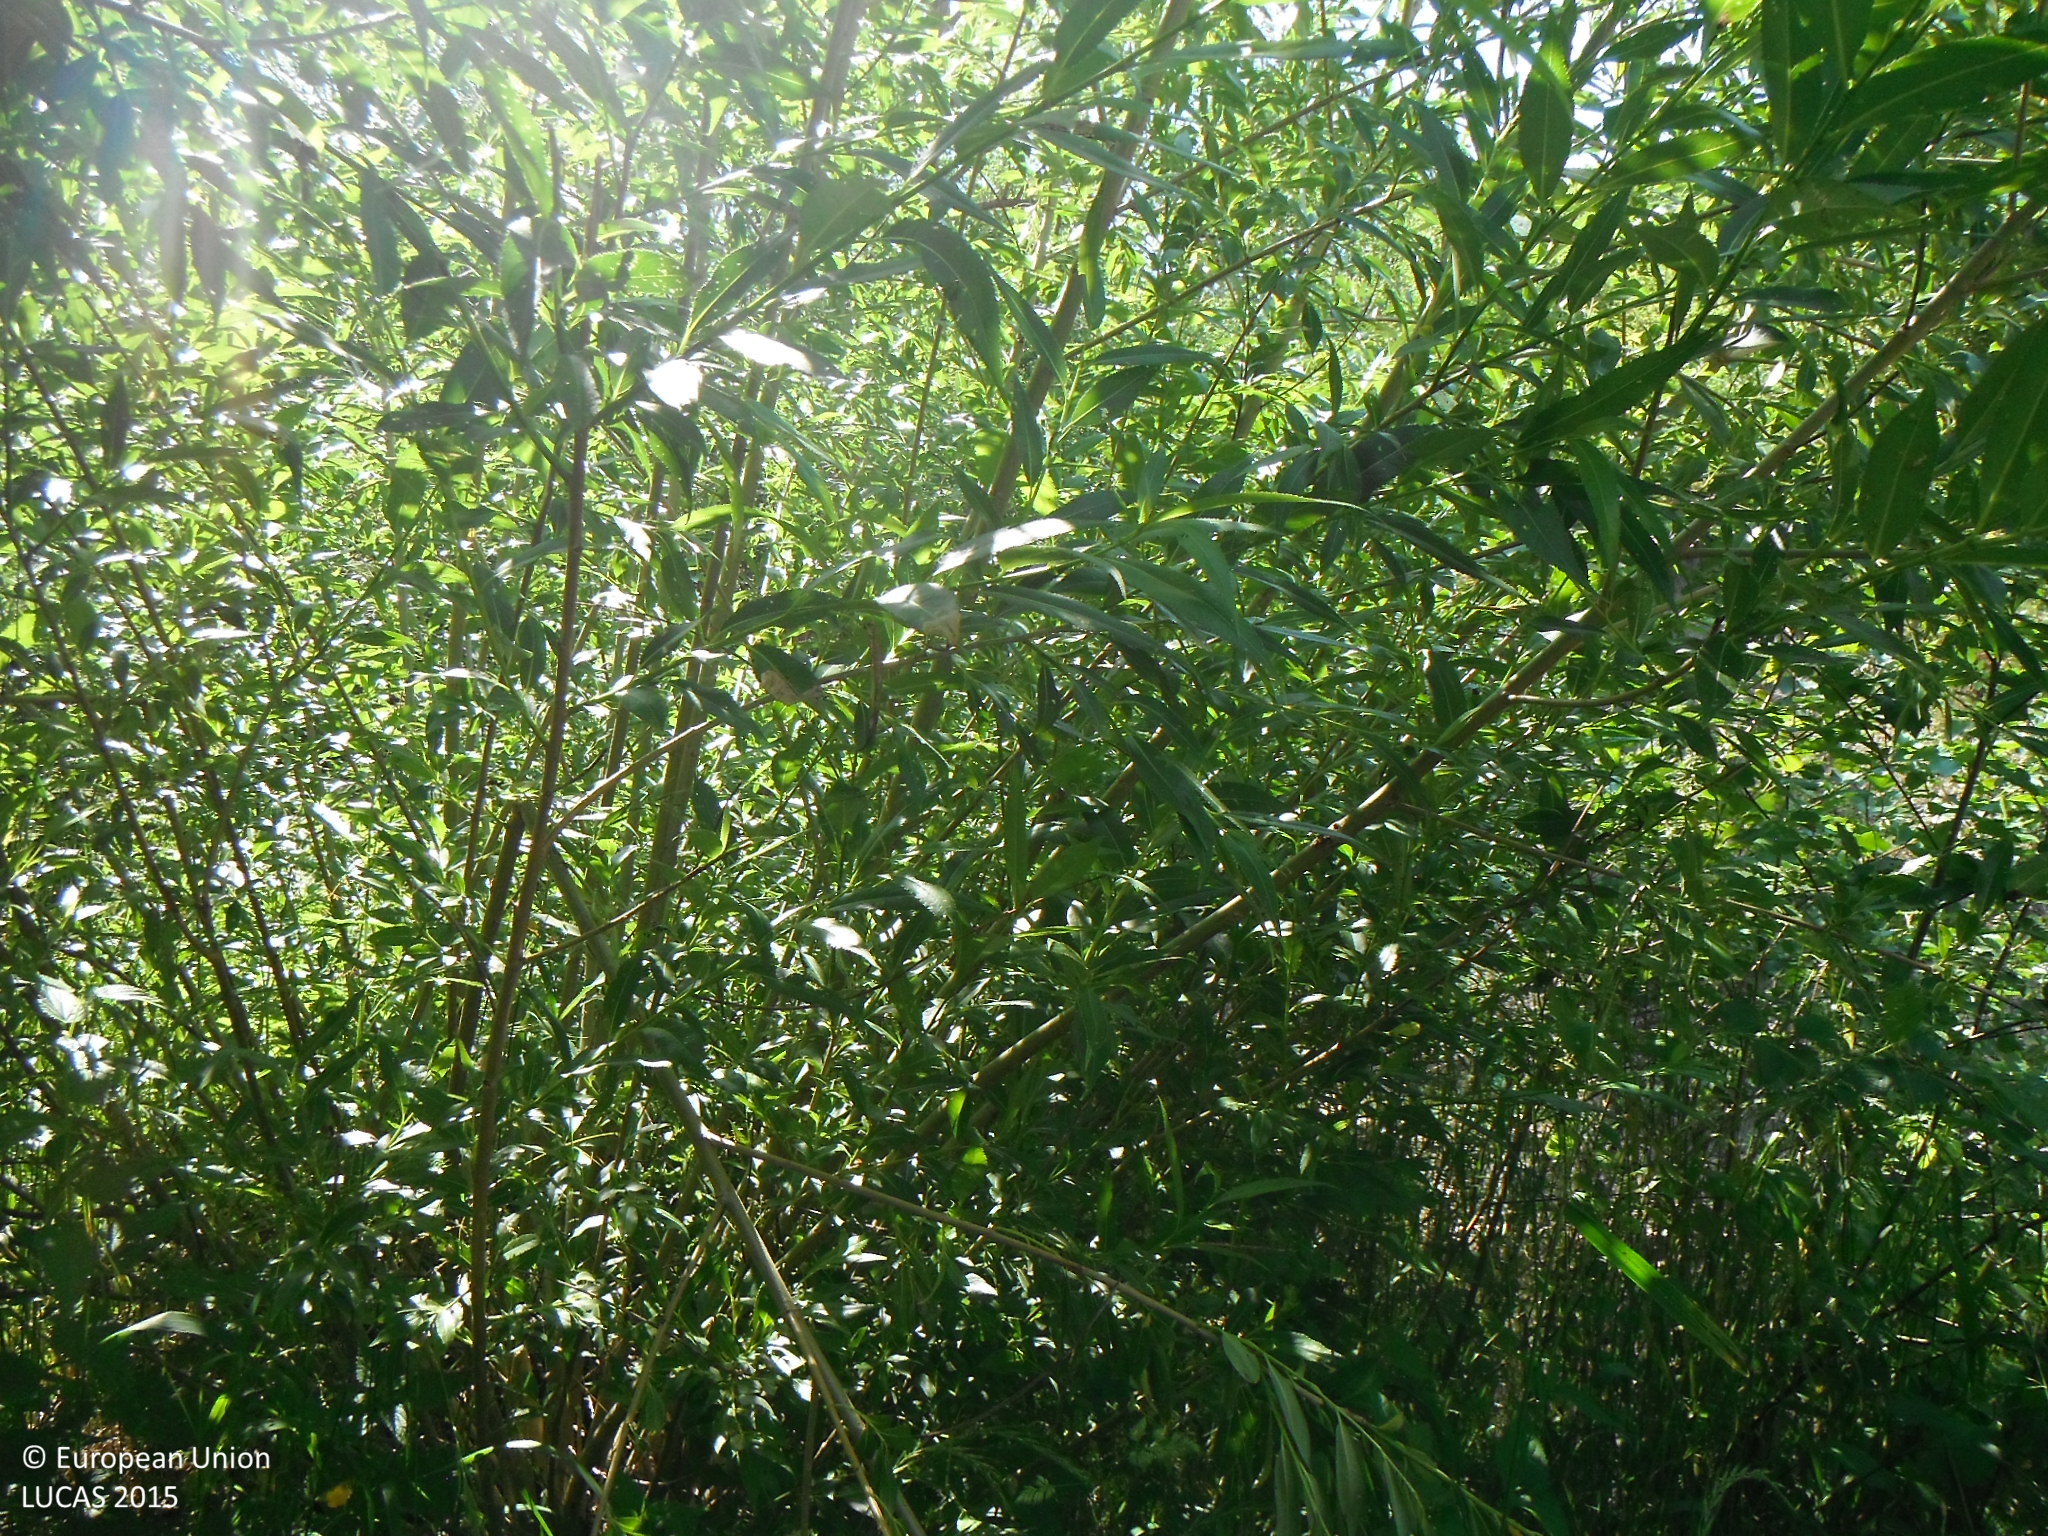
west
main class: Woodland
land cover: Broadleaved woodland
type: floodplain forest
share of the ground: 50 - 75 %
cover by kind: broadleaved forest trees 60 %, shrubs 20 %, herbaceous plants 20 %
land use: Semi-natural and natural areas not in use
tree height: > 5 m
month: July
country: SK
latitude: 49.1281
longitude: 19.5786
